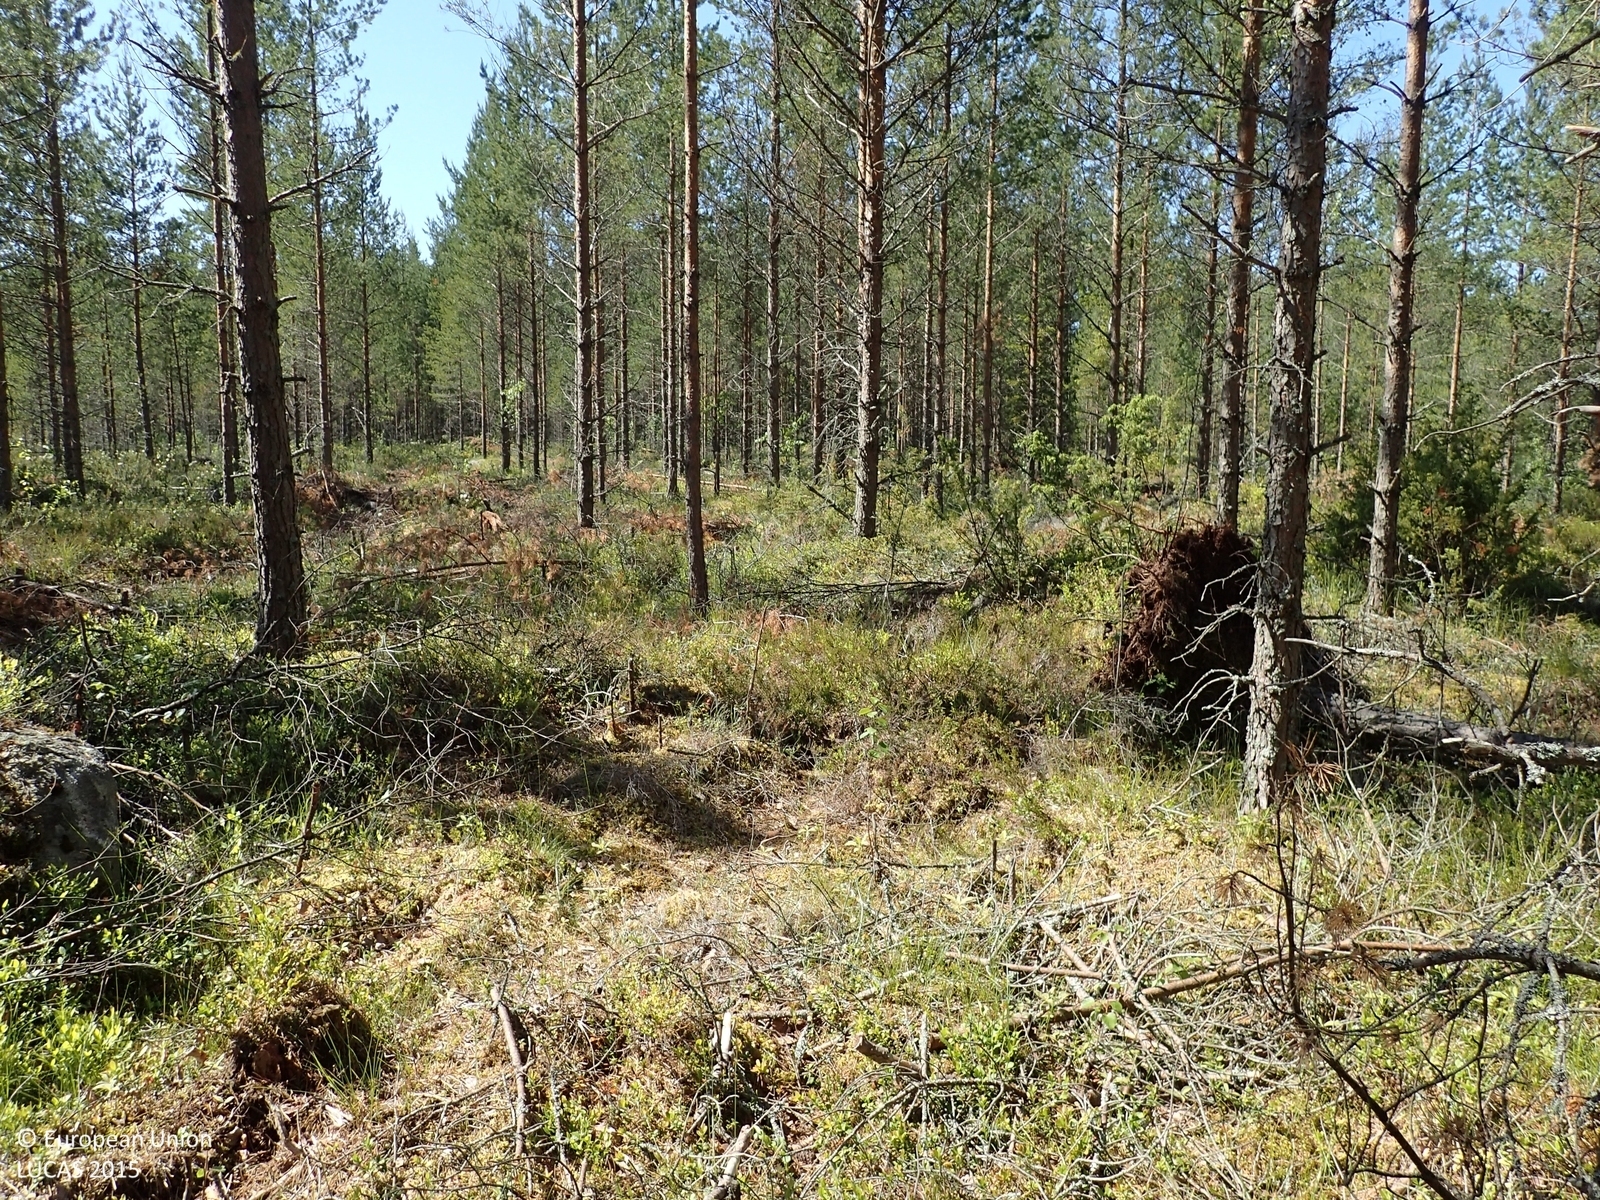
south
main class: Woodland
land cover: Pine dominated coniferous woodland
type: mire and swamp forests
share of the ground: 25 - 50 %
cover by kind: shrubs 50 %, coniferous forest trees 40 %, herbaceous plants 5 %, lichens and mosses 5 %
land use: Forestry
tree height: > 5 m
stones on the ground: < 10 %
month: June
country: FI
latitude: 62.4532
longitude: 21.3810
